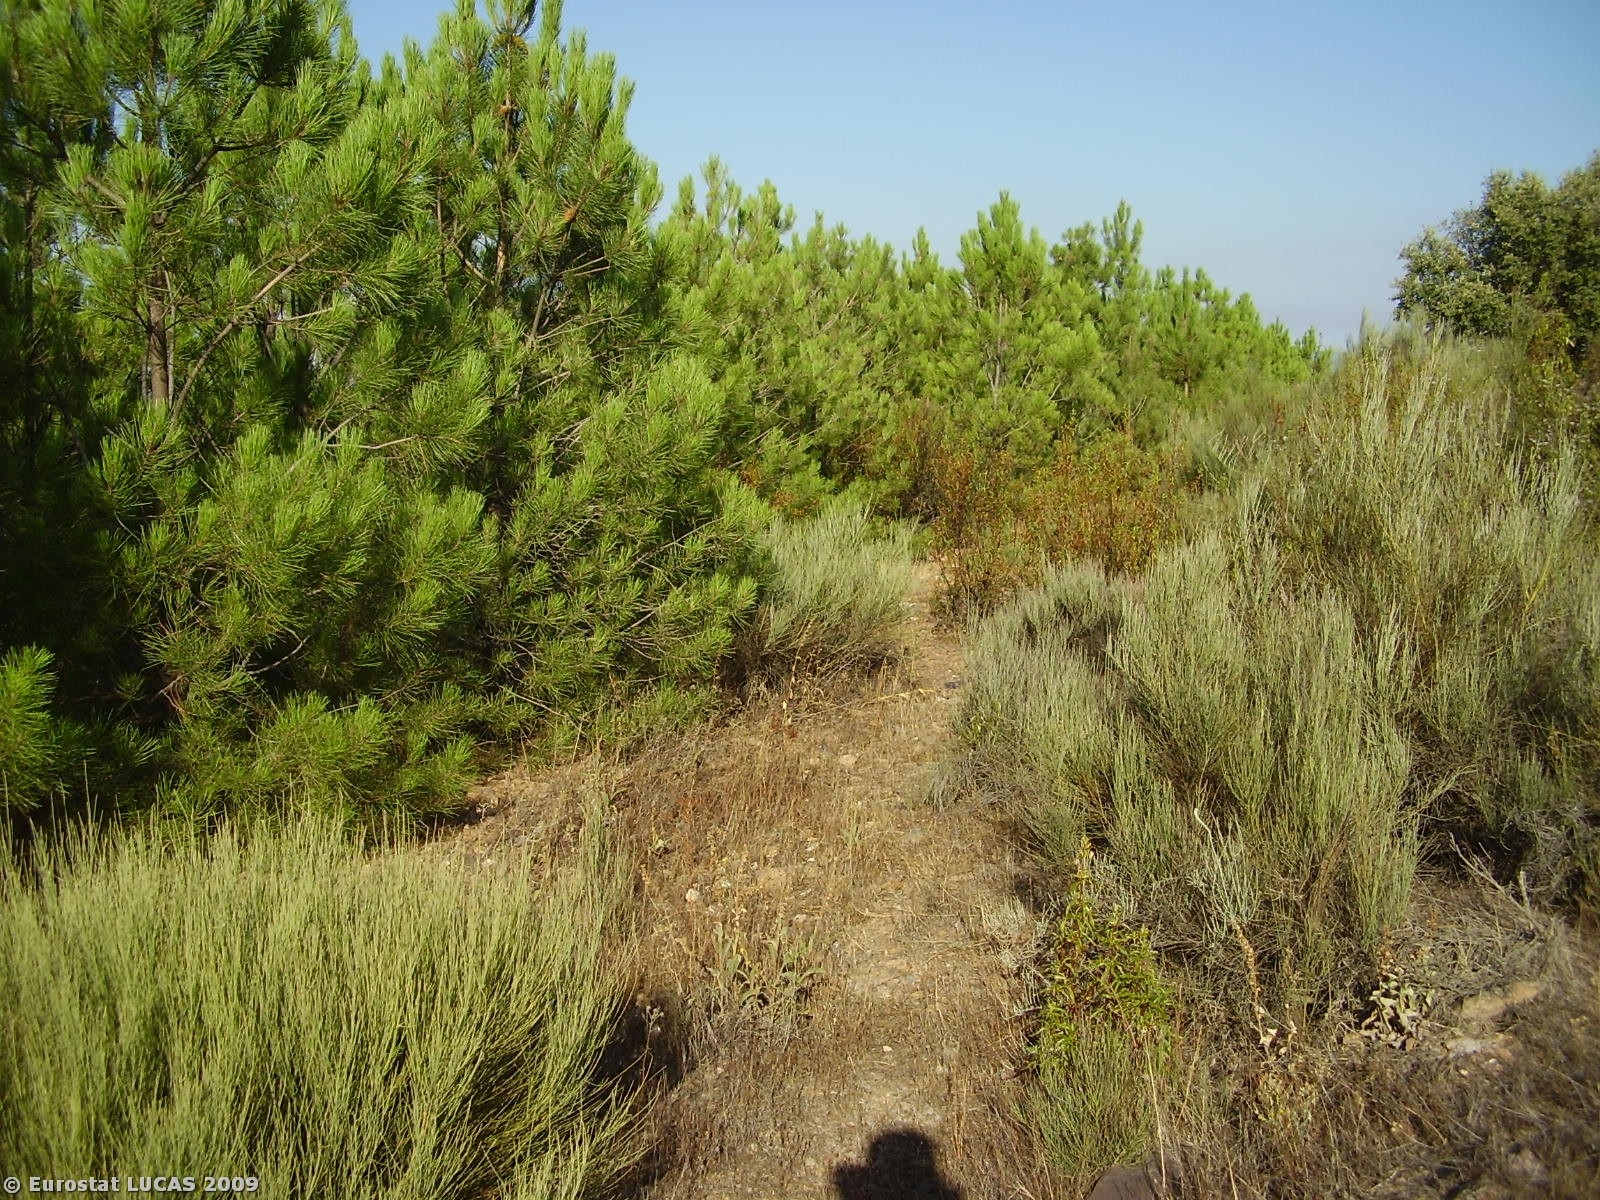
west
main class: Shrubland
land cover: Shrubland with sparse tree cover
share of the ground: > 75 %
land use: Fallow land
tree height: > 5 m
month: August
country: PT
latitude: 41.3567
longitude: -6.7573
